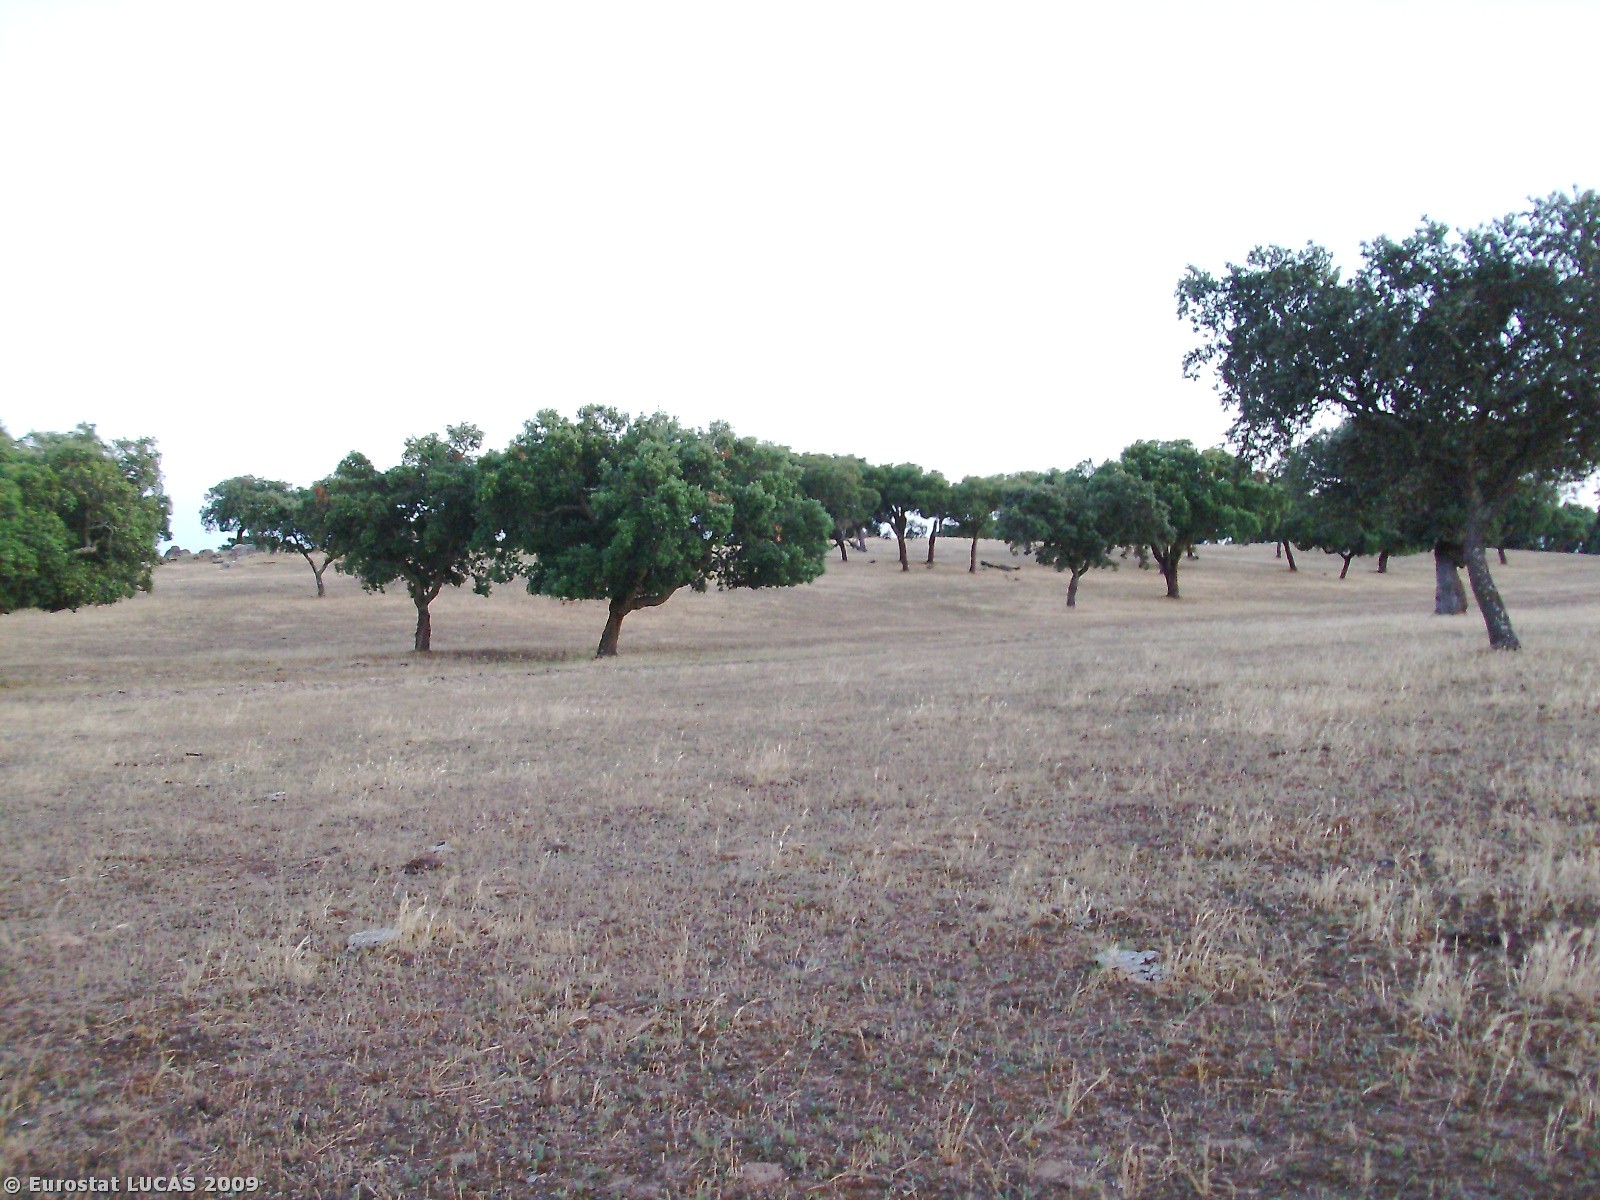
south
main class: Grassland
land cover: Grassland with sparse tree/shrub cover
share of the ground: > 75 %
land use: Agriculture (excluding fallow land and kitchen gardens)
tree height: > 5 m
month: May
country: PT
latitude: 38.9518
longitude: -7.3297
